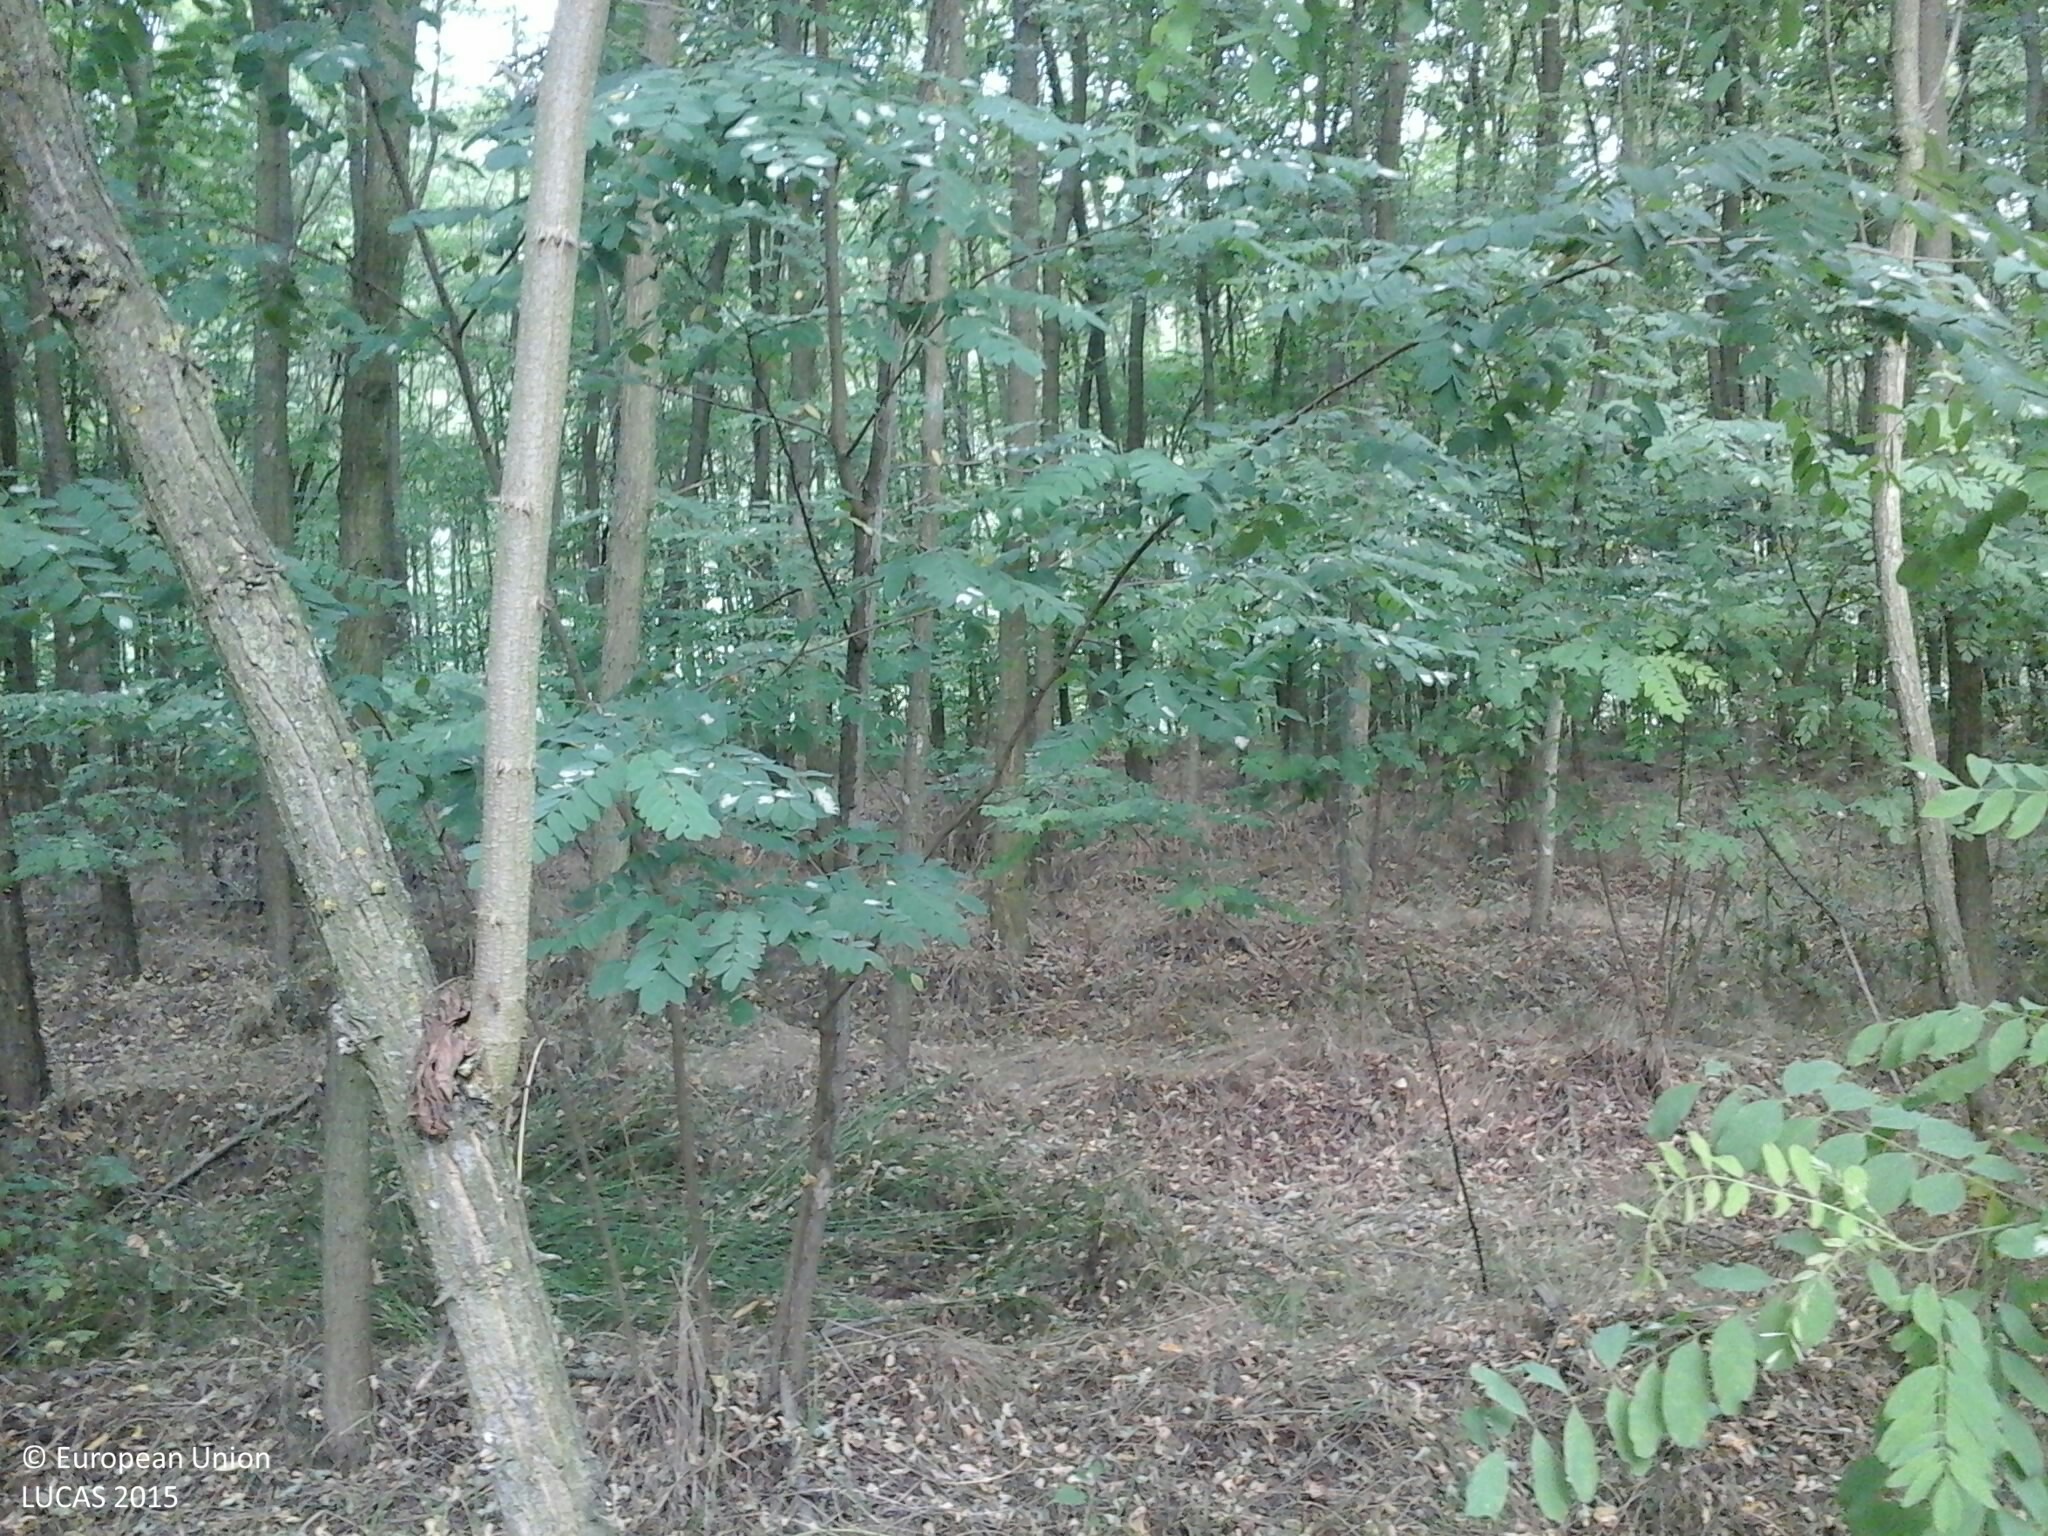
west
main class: Woodland
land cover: Broadleaved woodland
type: exotic forest
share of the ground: > 75 %
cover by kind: broadleaved forest trees 95 %, herbaceous plants 5 %
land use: Forestry
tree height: > 5 m
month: July
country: HU
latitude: 47.7871
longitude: 22.1328
